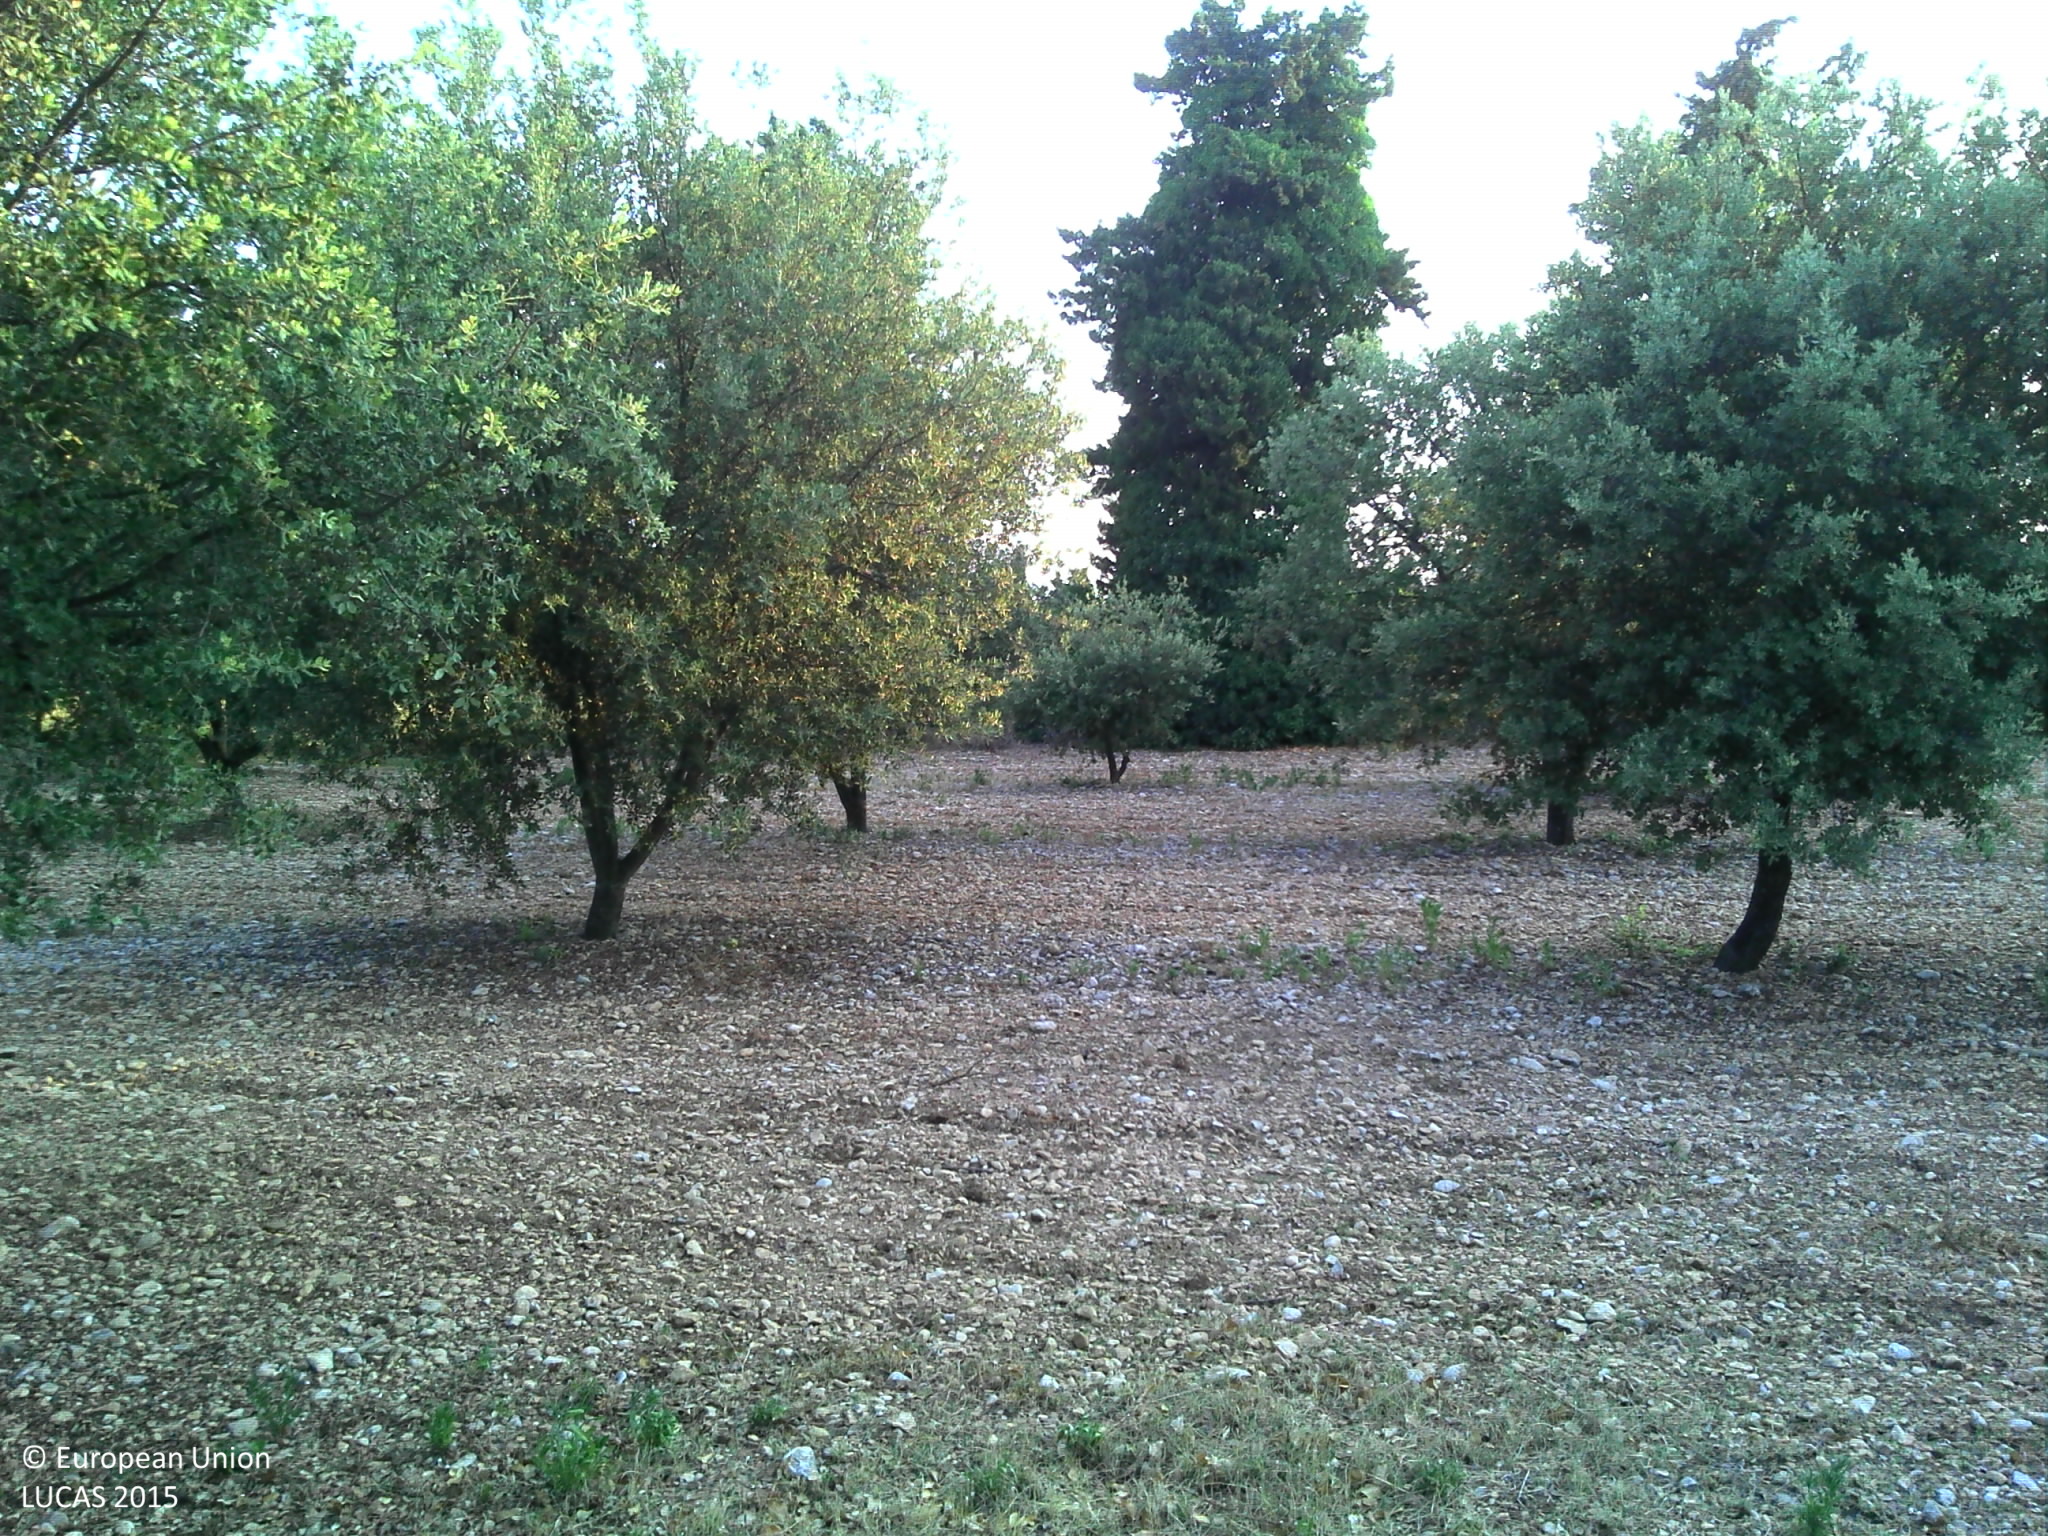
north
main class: Cropland
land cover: Pear fruit
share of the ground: 25 - 50 %
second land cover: Other bare soil
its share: > 75 %
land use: Agriculture (excluding fallow land and kitchen gardens)
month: July
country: FR
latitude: 44.0159
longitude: 5.0561
